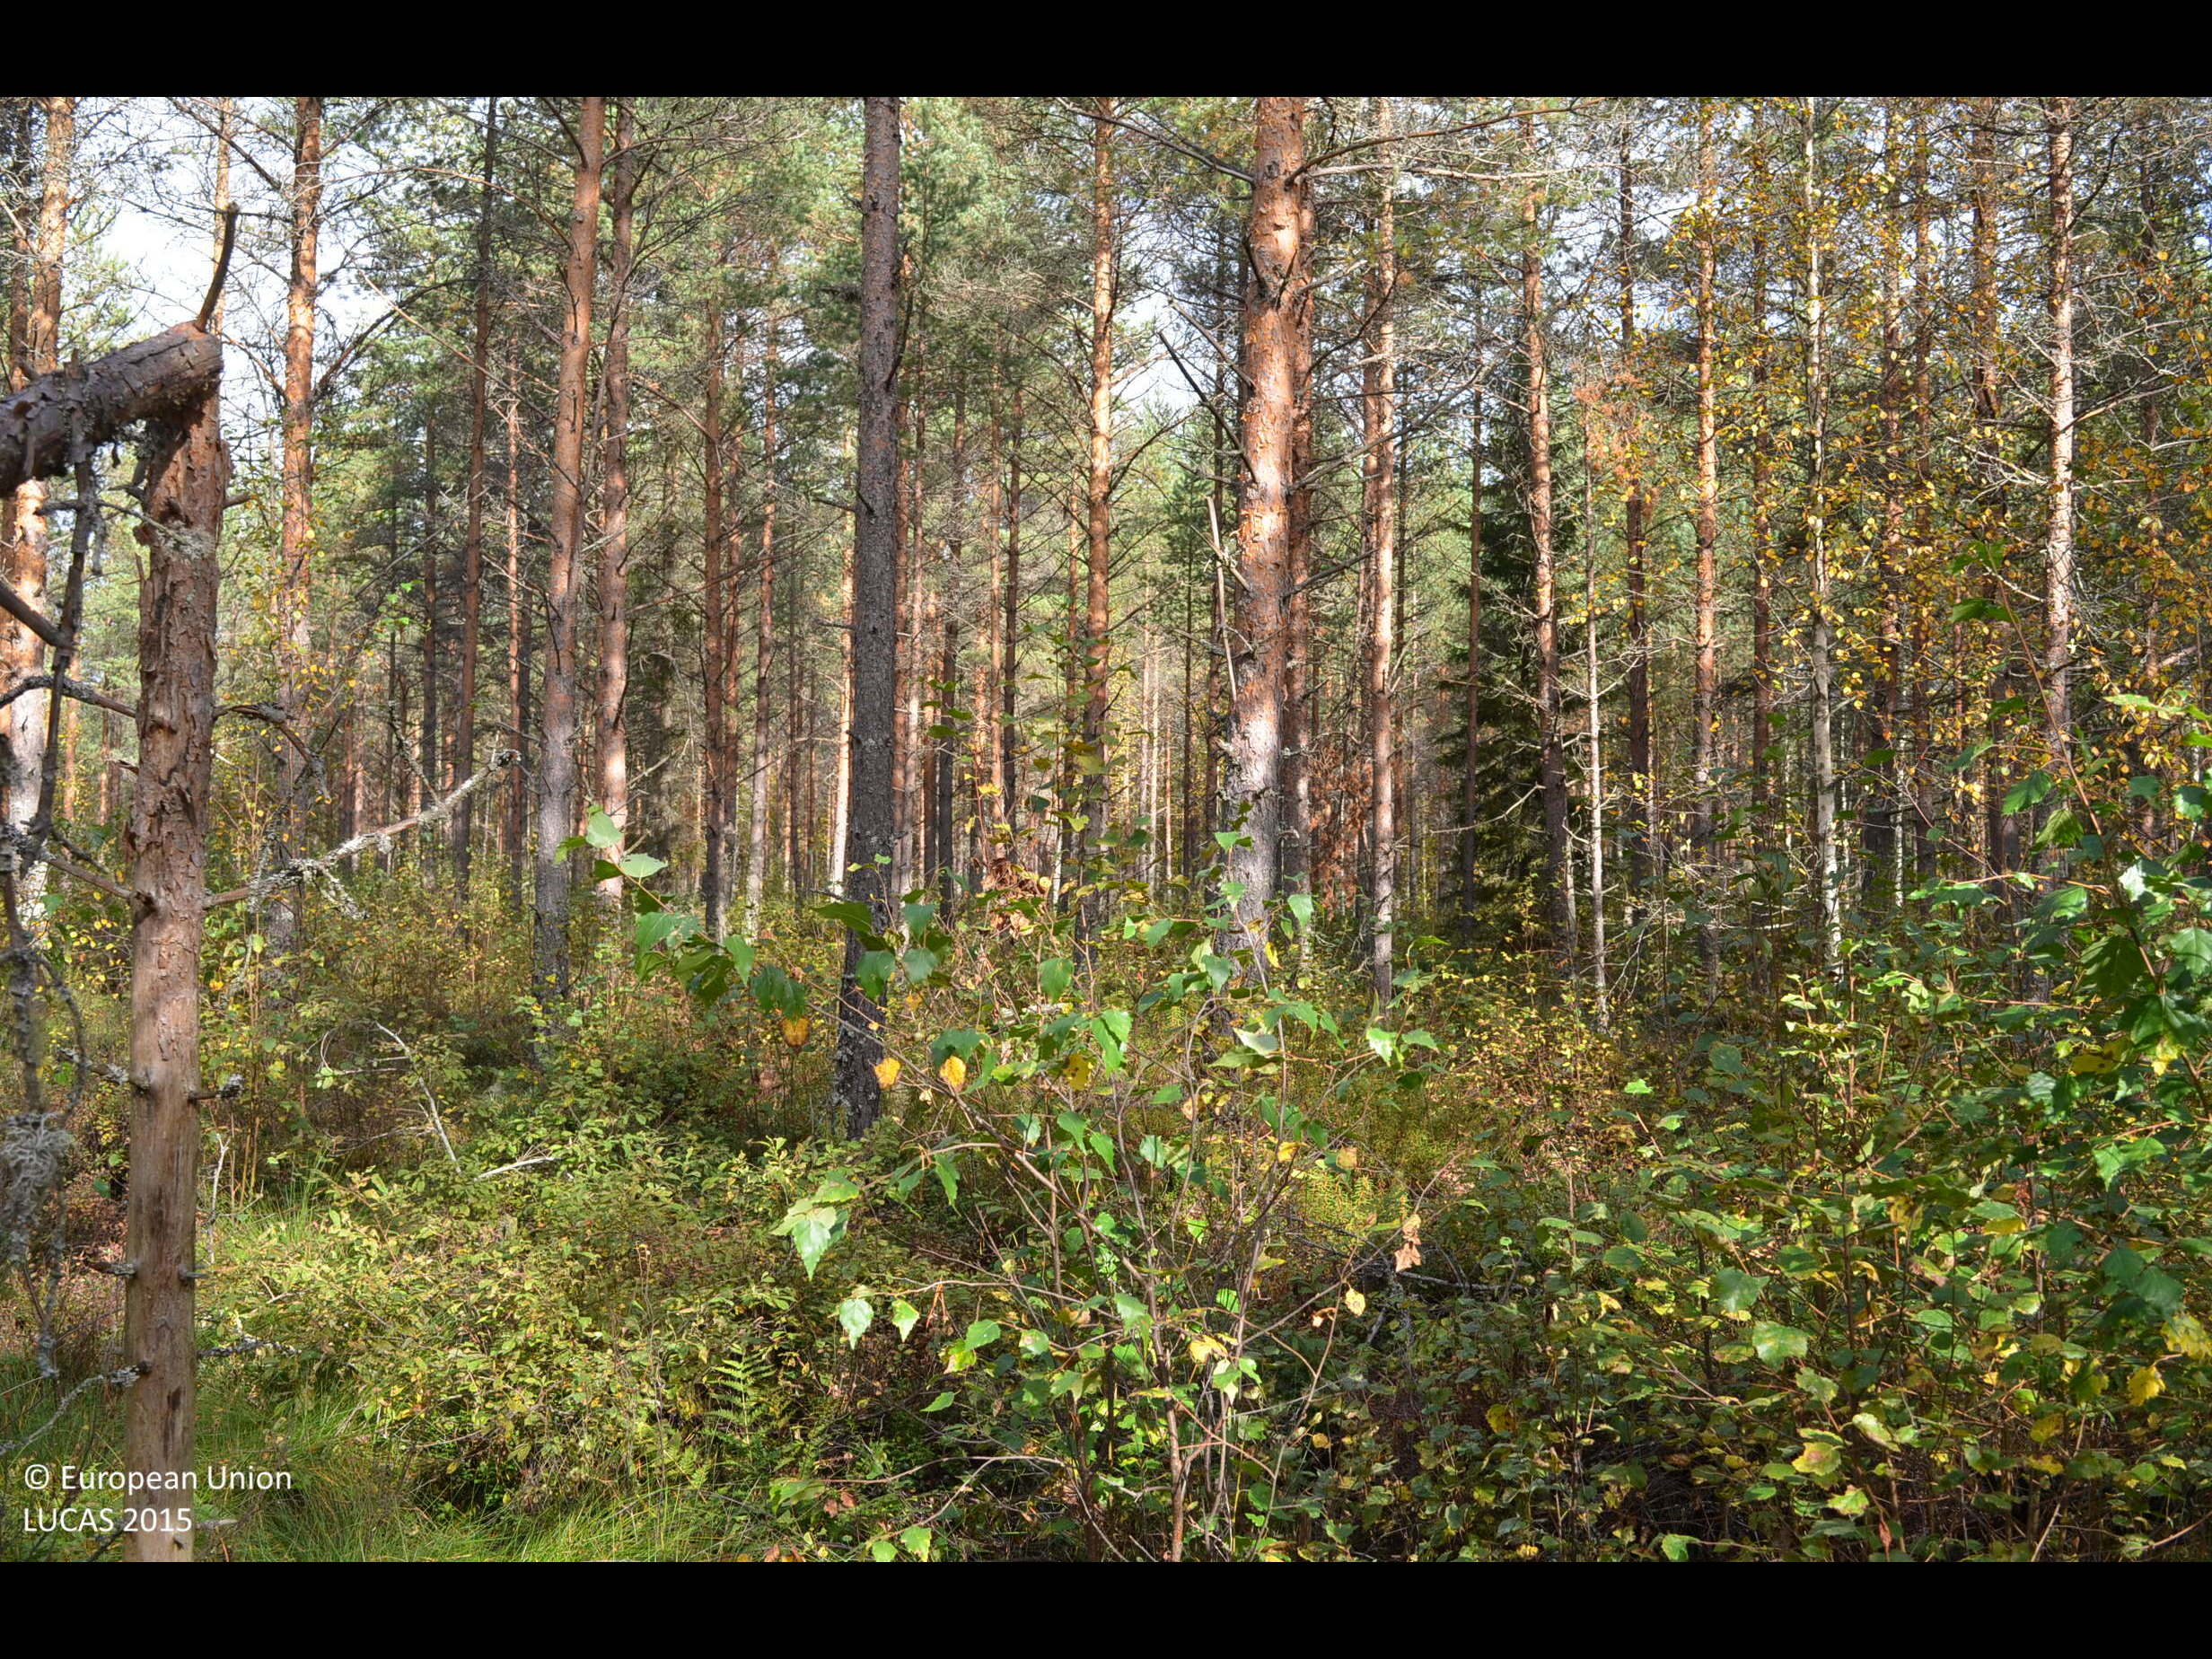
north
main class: Woodland
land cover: Pine dominated coniferous woodland
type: boreal forest
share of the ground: > 75 %
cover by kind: coniferous forest trees 60 %, shrubs 20 %, broadleaved forest trees 15 %, herbaceous plants 5 %
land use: Forestry
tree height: > 5 m
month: September
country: FI
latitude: 62.9206
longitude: 23.8767
